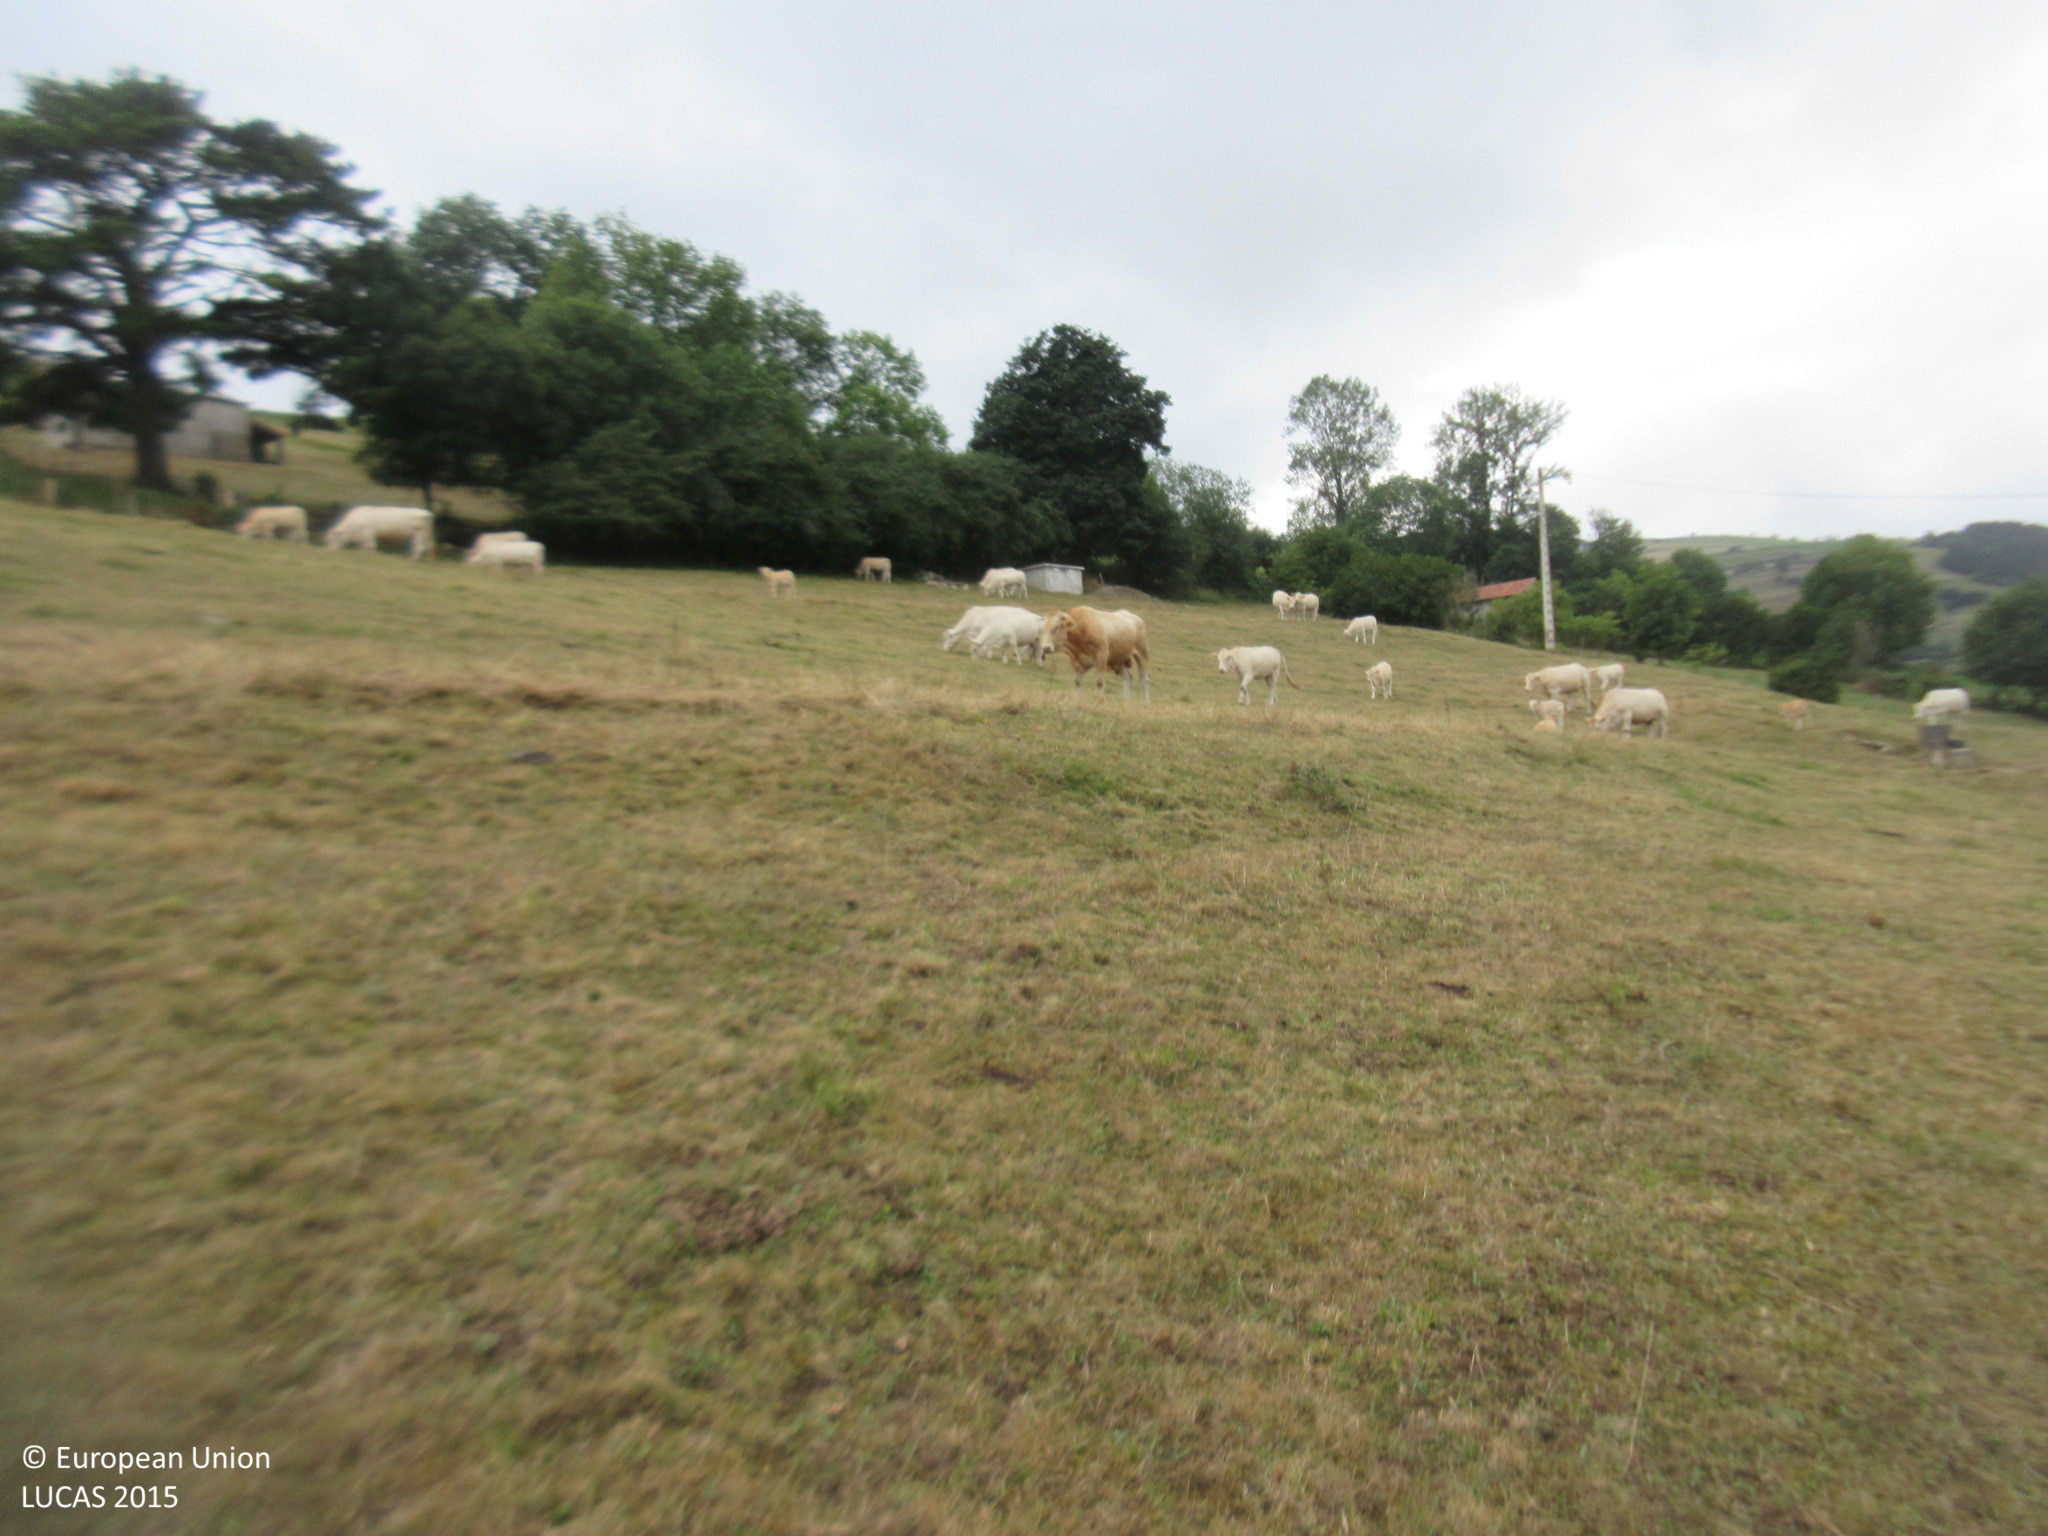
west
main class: Grassland
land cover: Grassland without tree/shrub cover
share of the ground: > 75 %
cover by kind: herbaceous plants 100 %
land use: Agriculture (excluding fallow land and kitchen gardens)
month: July
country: ES
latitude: 43.2026
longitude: -3.9438
